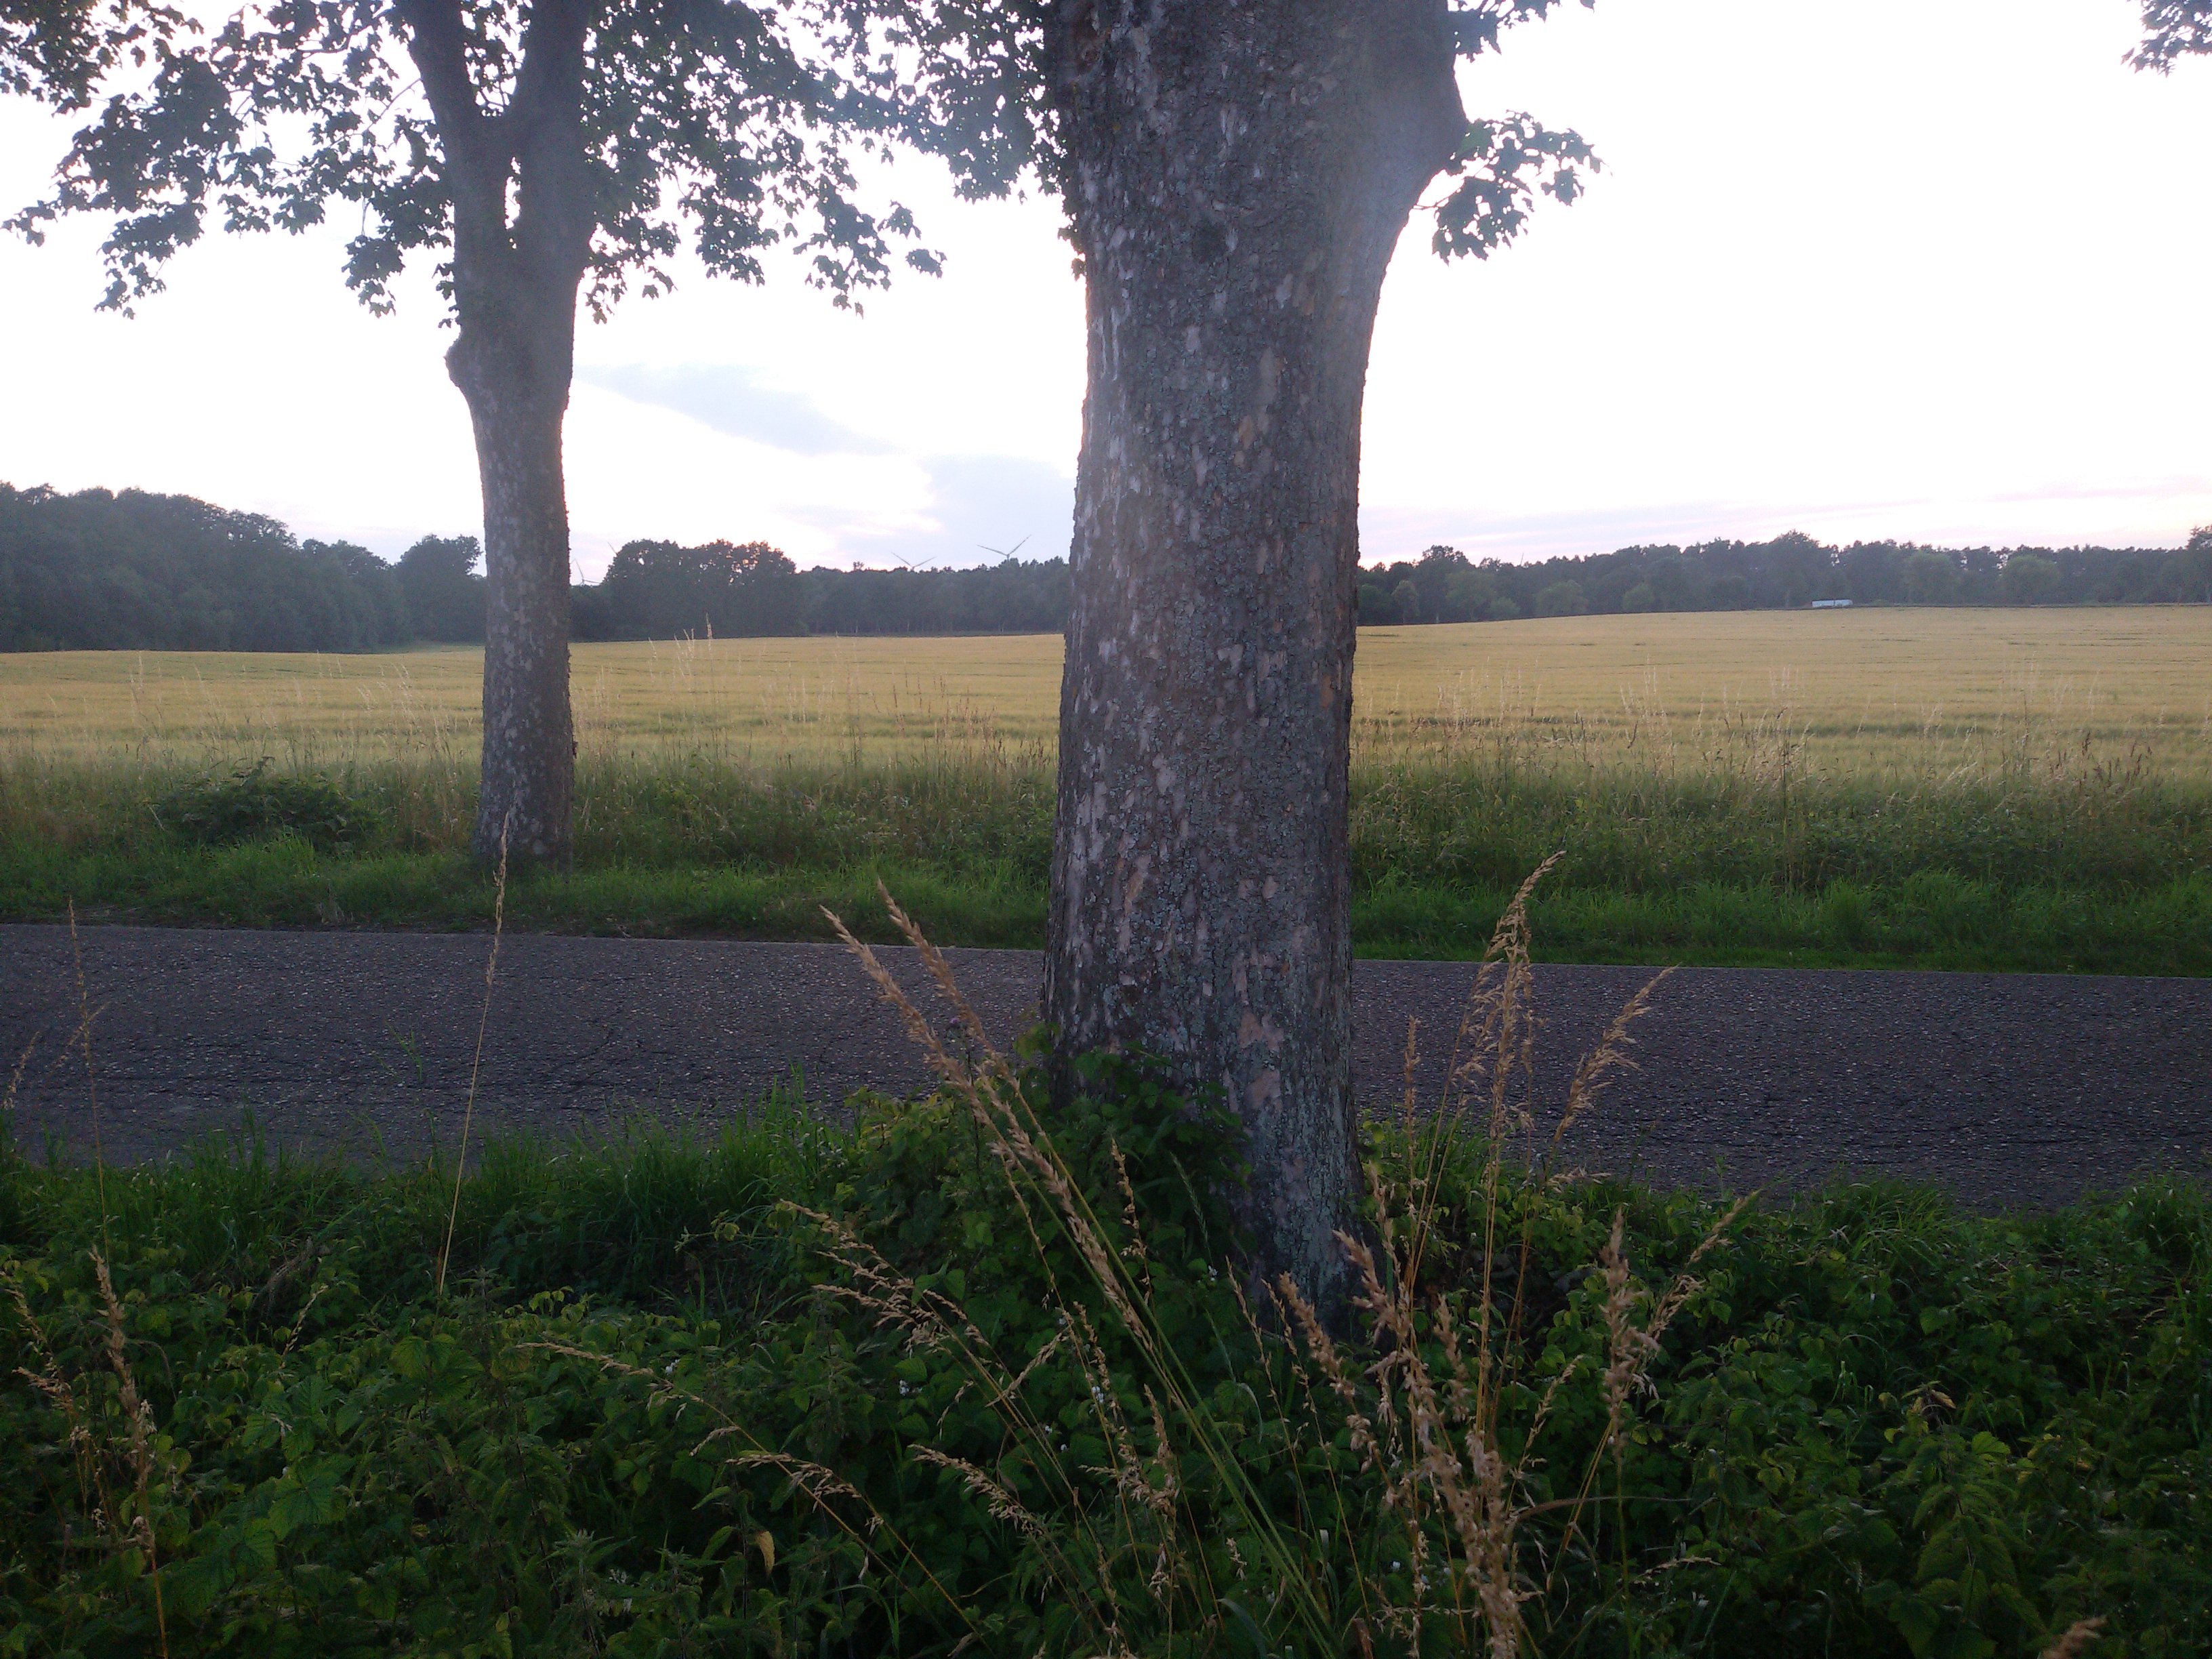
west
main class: Cropland
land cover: Tobacco
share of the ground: > 75 %
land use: Agriculture (excluding fallow land and kitchen gardens)
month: July
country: PL
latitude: 54.0176
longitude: 15.8493
